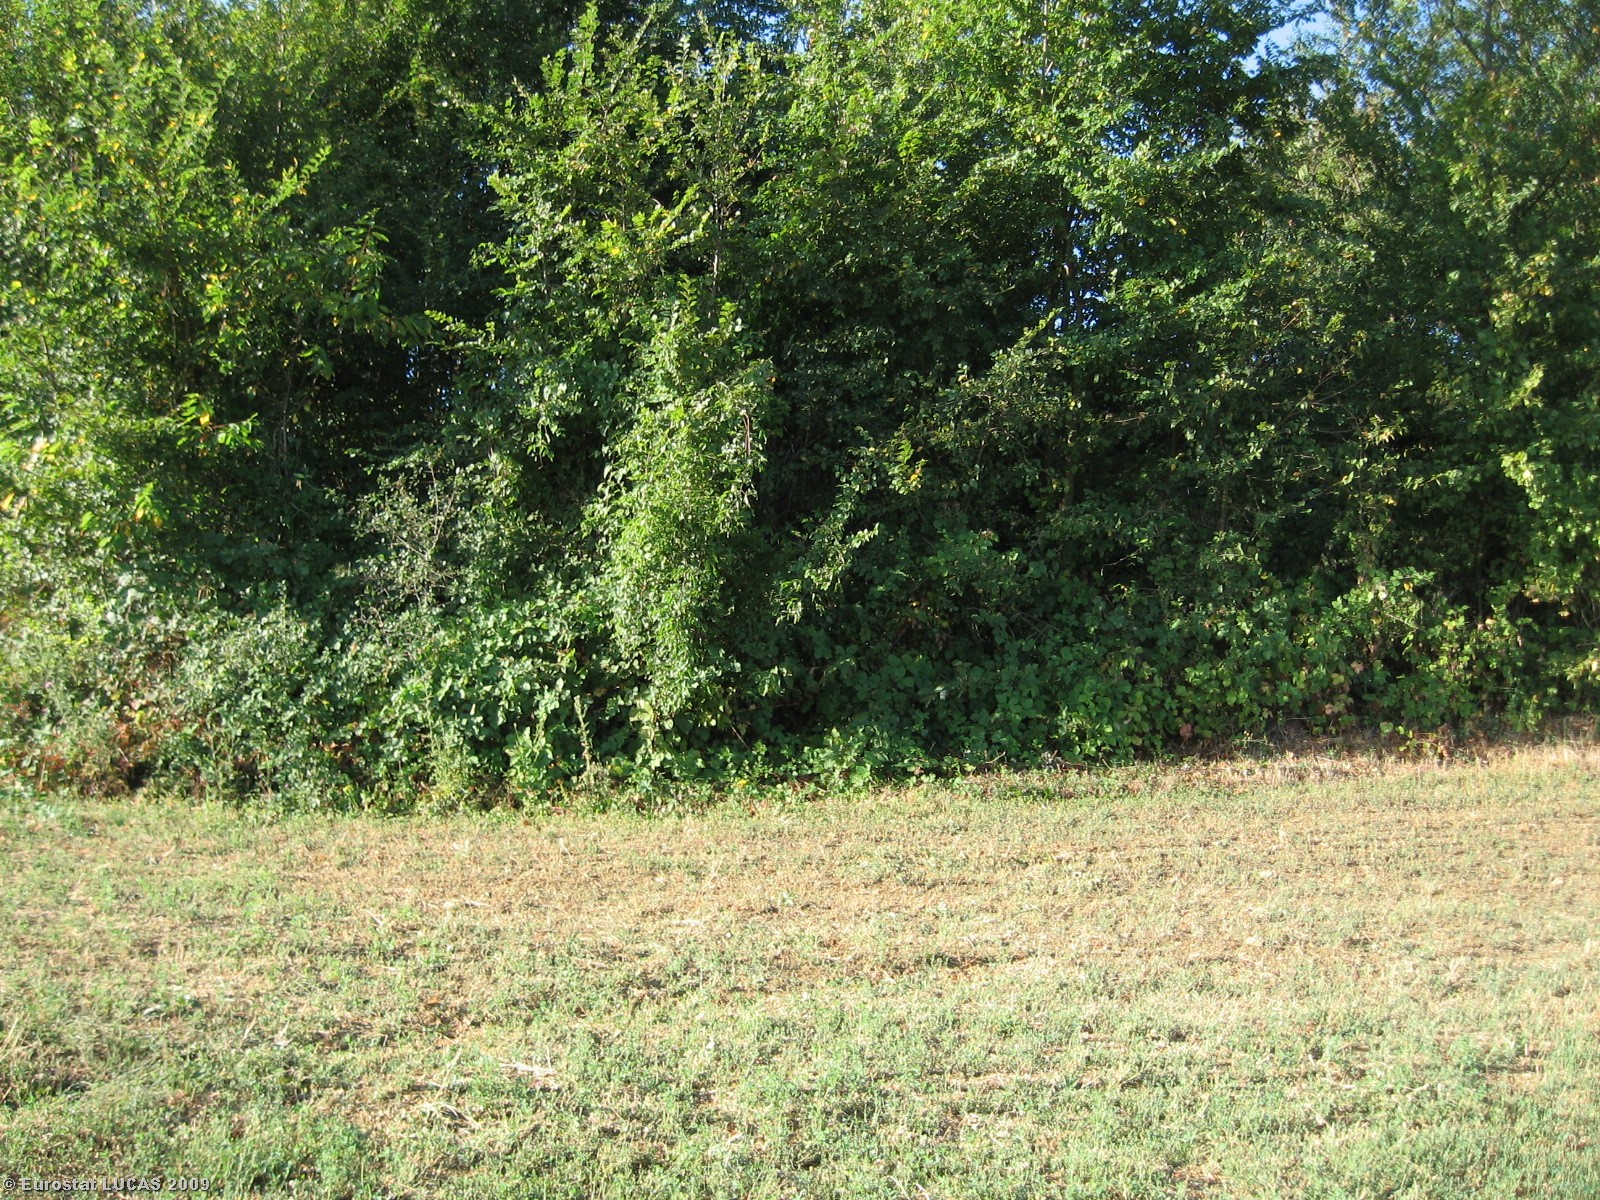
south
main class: Cropland
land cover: Lucerne
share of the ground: > 75 %
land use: Agriculture (excluding fallow land and kitchen gardens)
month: August
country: IT
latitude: 44.9085
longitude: 9.5323
